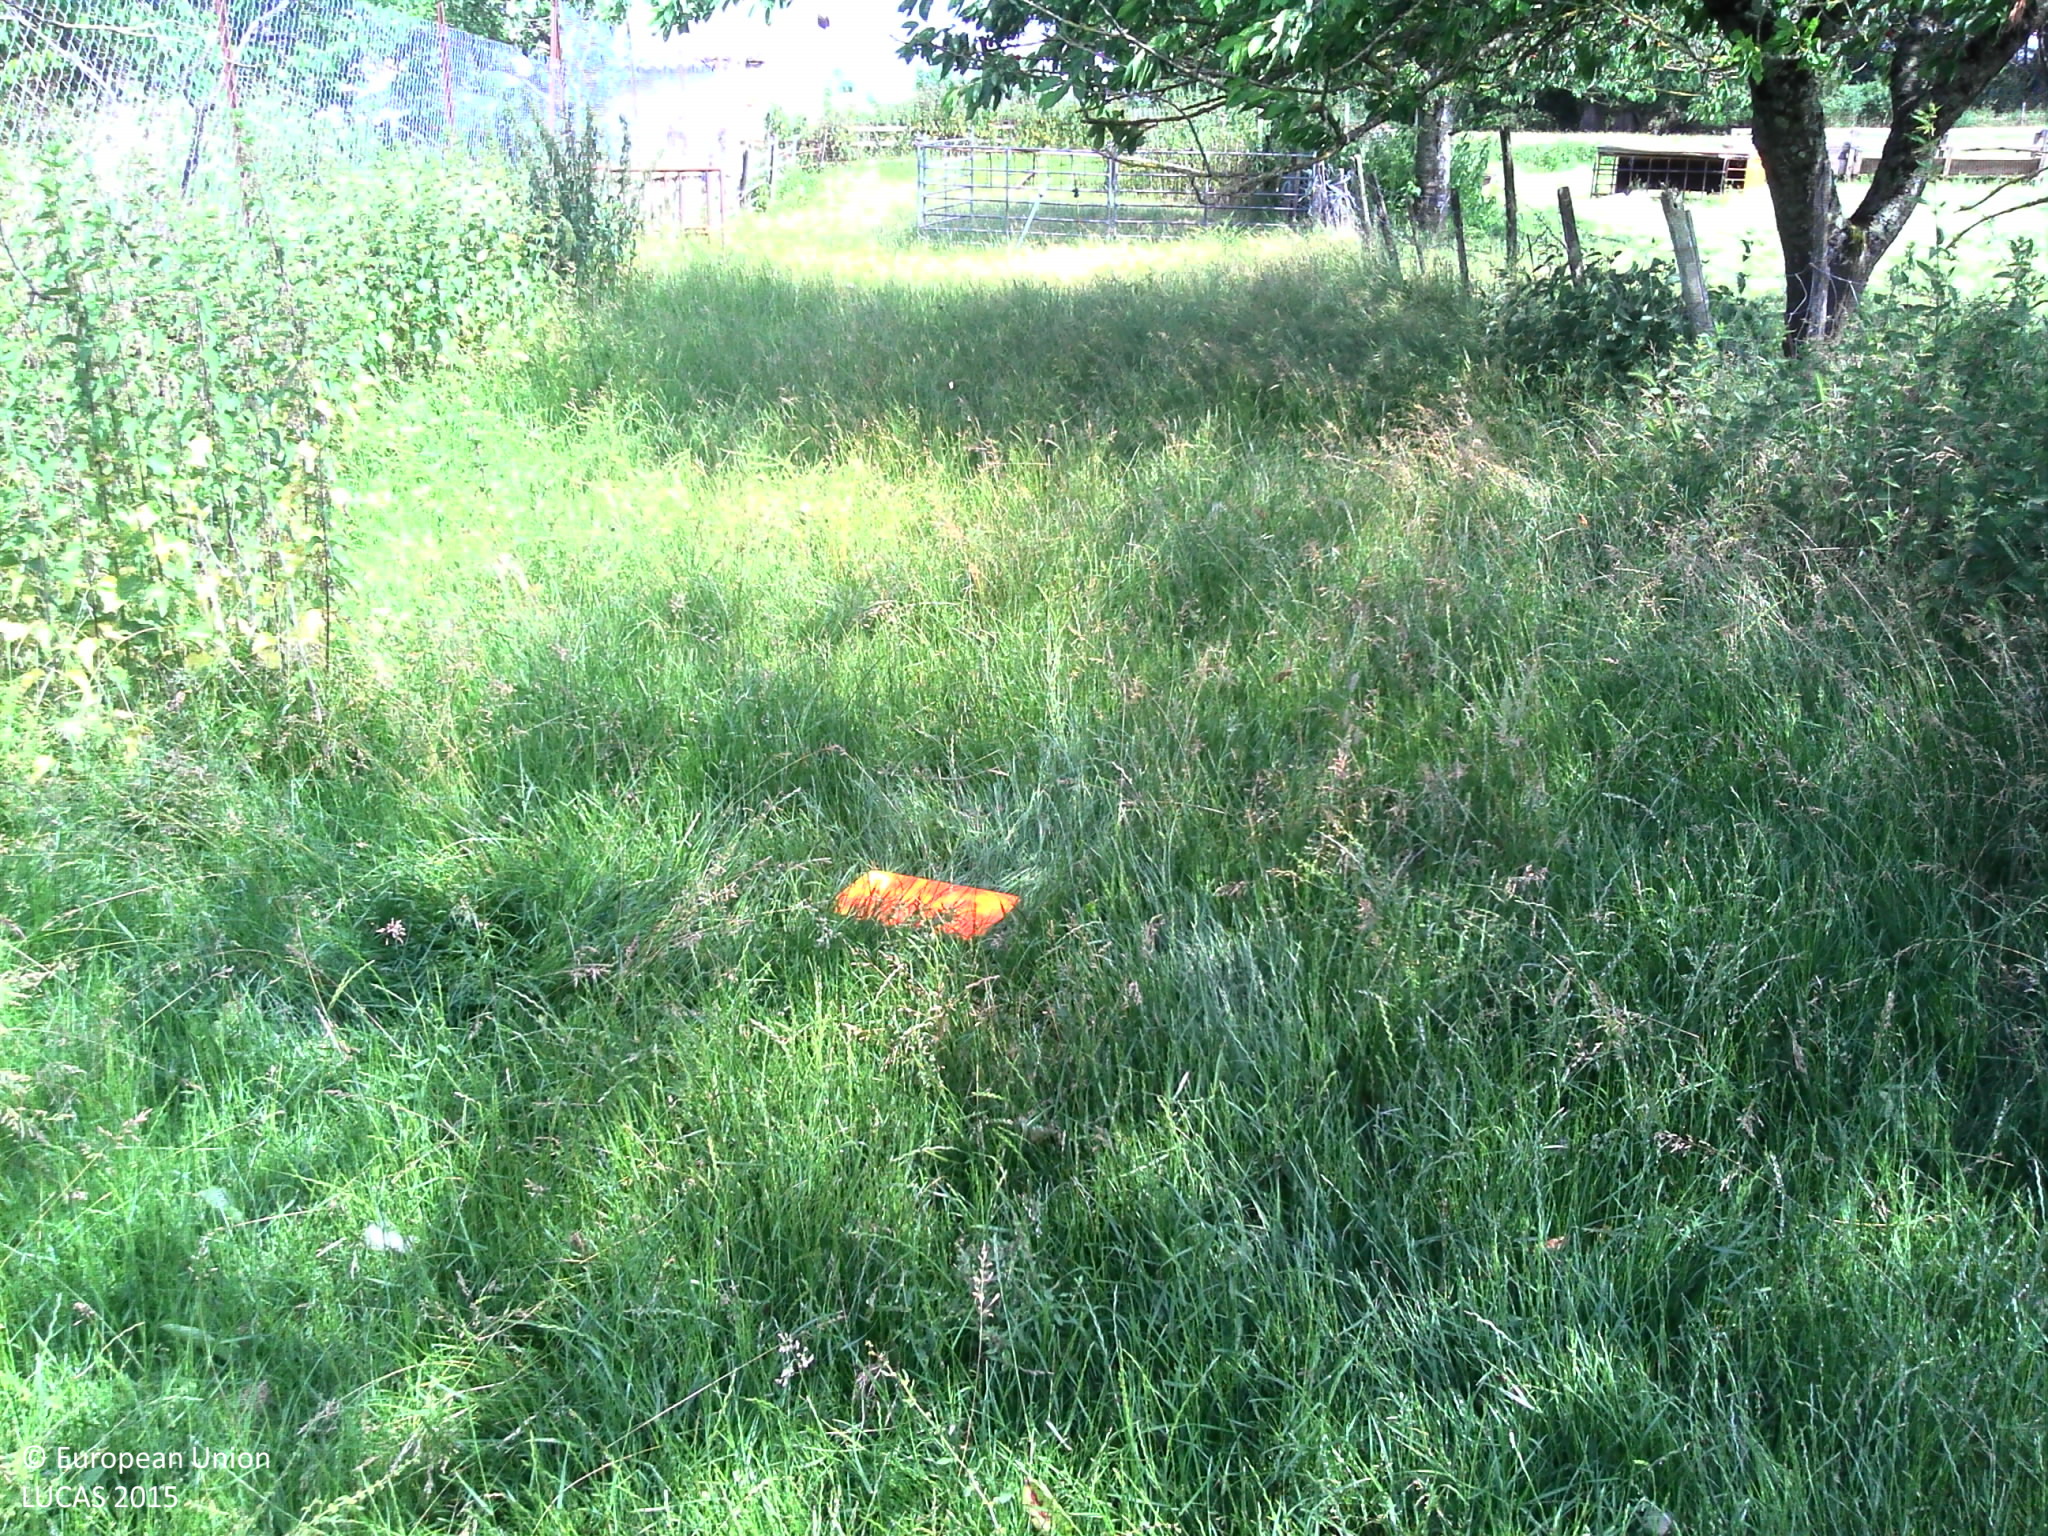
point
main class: Grassland
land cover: Grassland with sparse tree/shrub cover
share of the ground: > 75 %
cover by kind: herbaceous plants 95 %, broadleaved forest trees 5 %
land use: Agriculture (excluding fallow land and kitchen gardens)
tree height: > 5 m
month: June
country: FR
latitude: 46.6649
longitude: 0.8488
